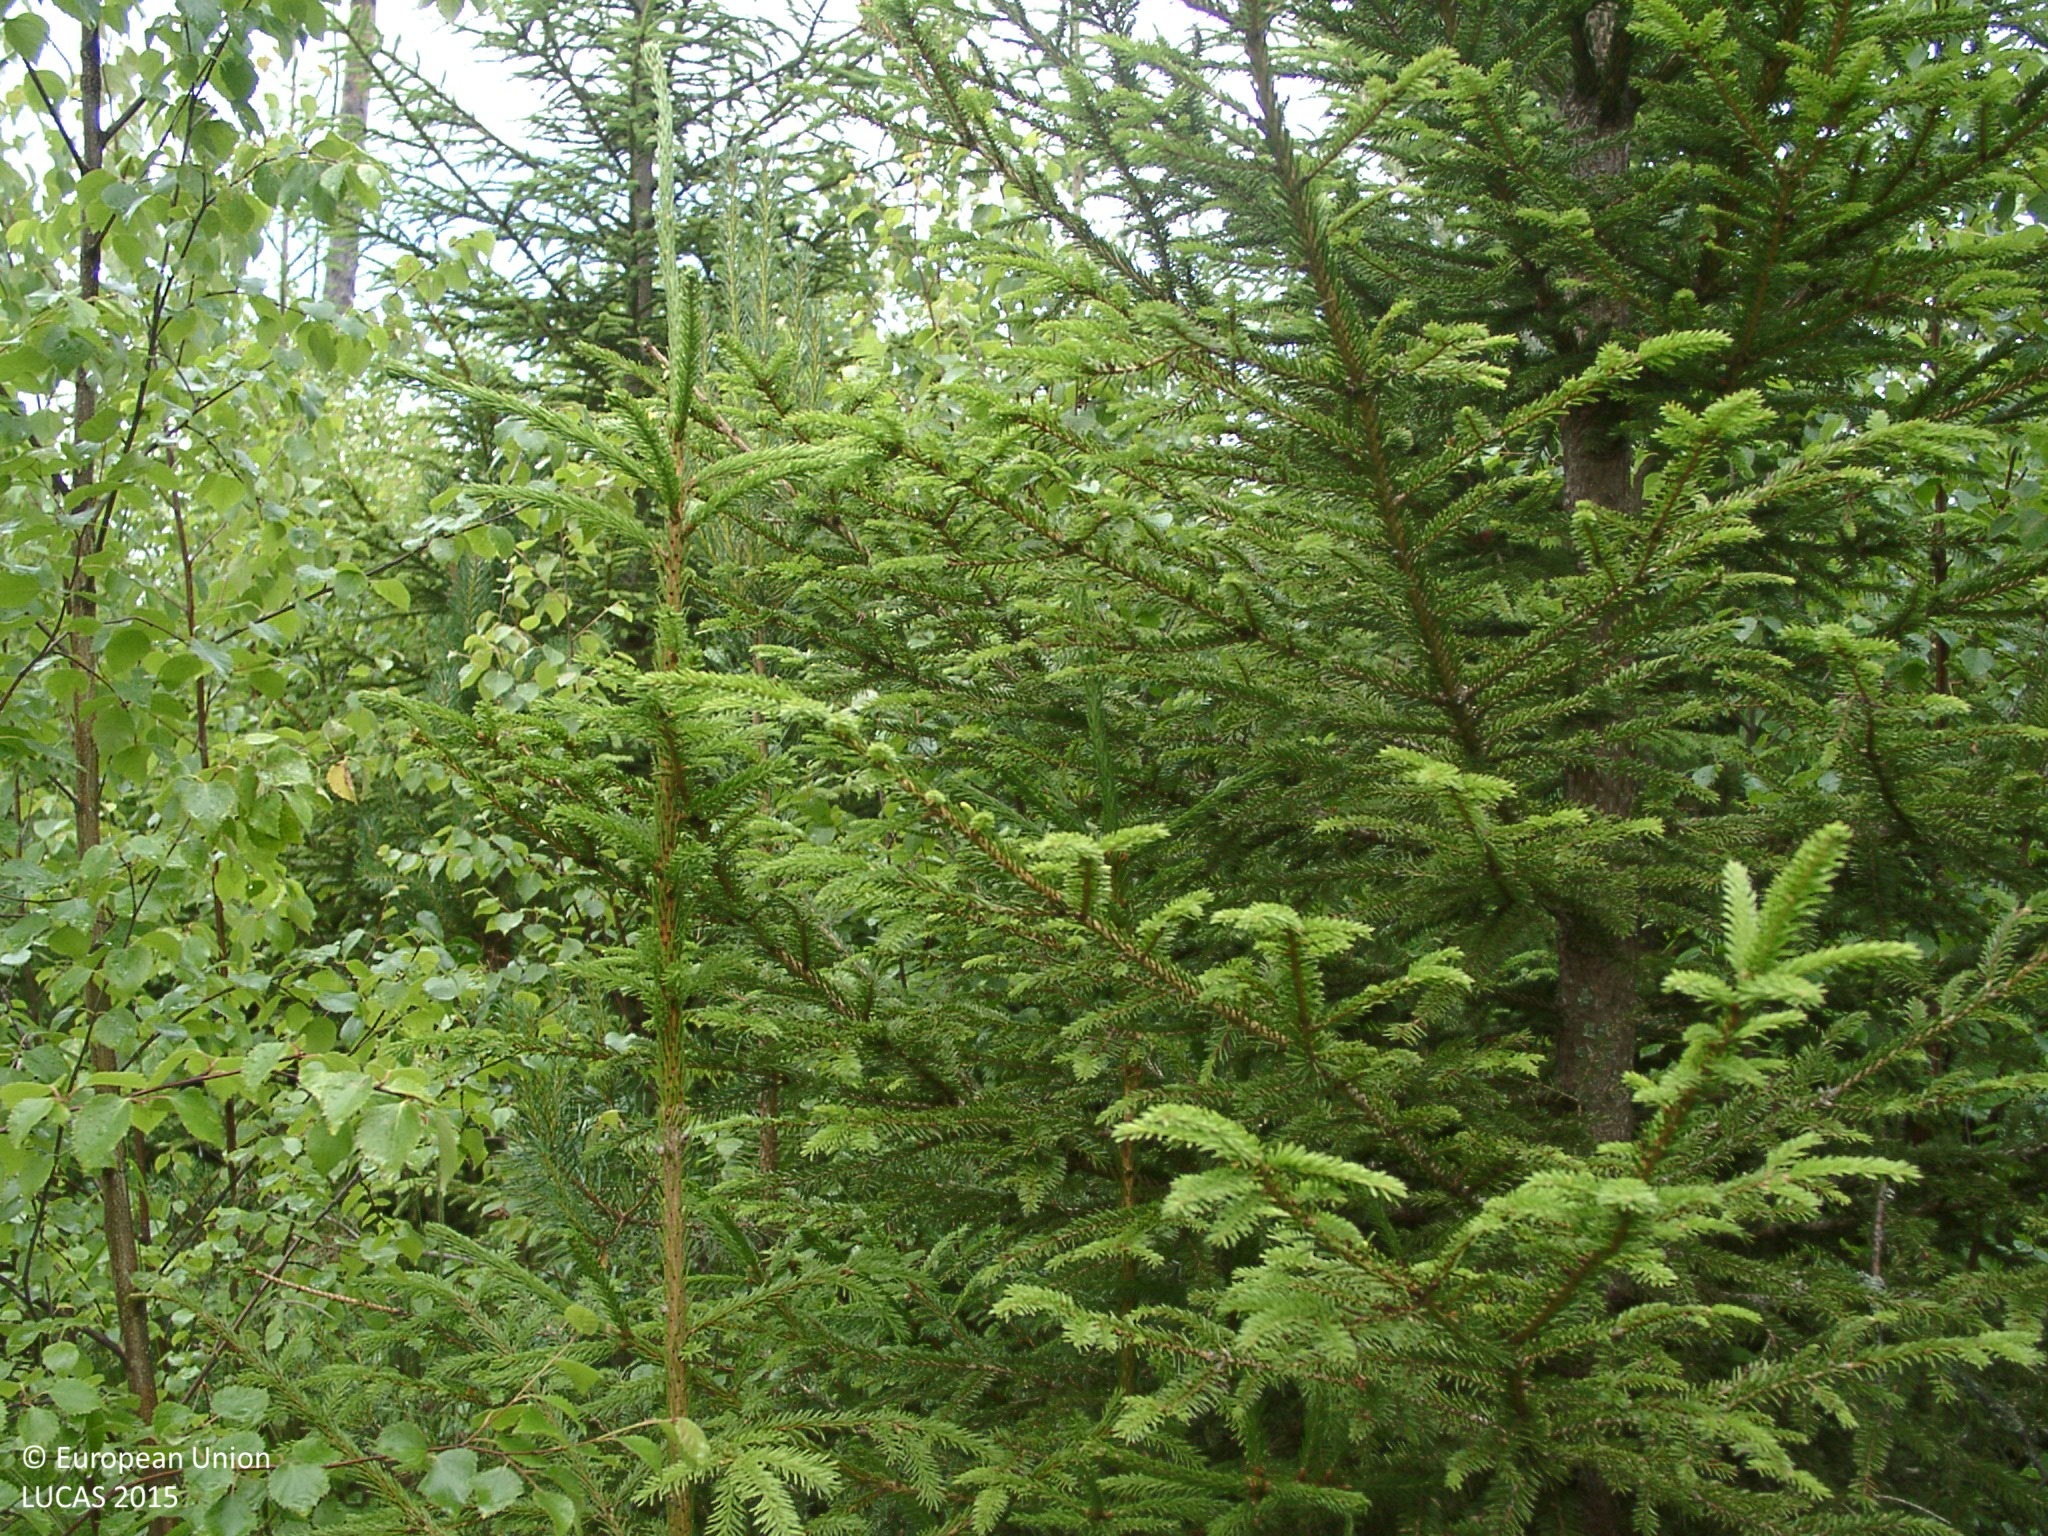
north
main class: Woodland
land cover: Spruce dominated mixed woodland
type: boreal forest
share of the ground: > 75 %
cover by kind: broadleaved forest trees 45 %, coniferous forest trees 40 %, shrubs 10 %, herbaceous plants 5 %
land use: Forestry
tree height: < 5 m
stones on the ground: < 10 %
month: July
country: FI
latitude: 61.5450
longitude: 25.1446
